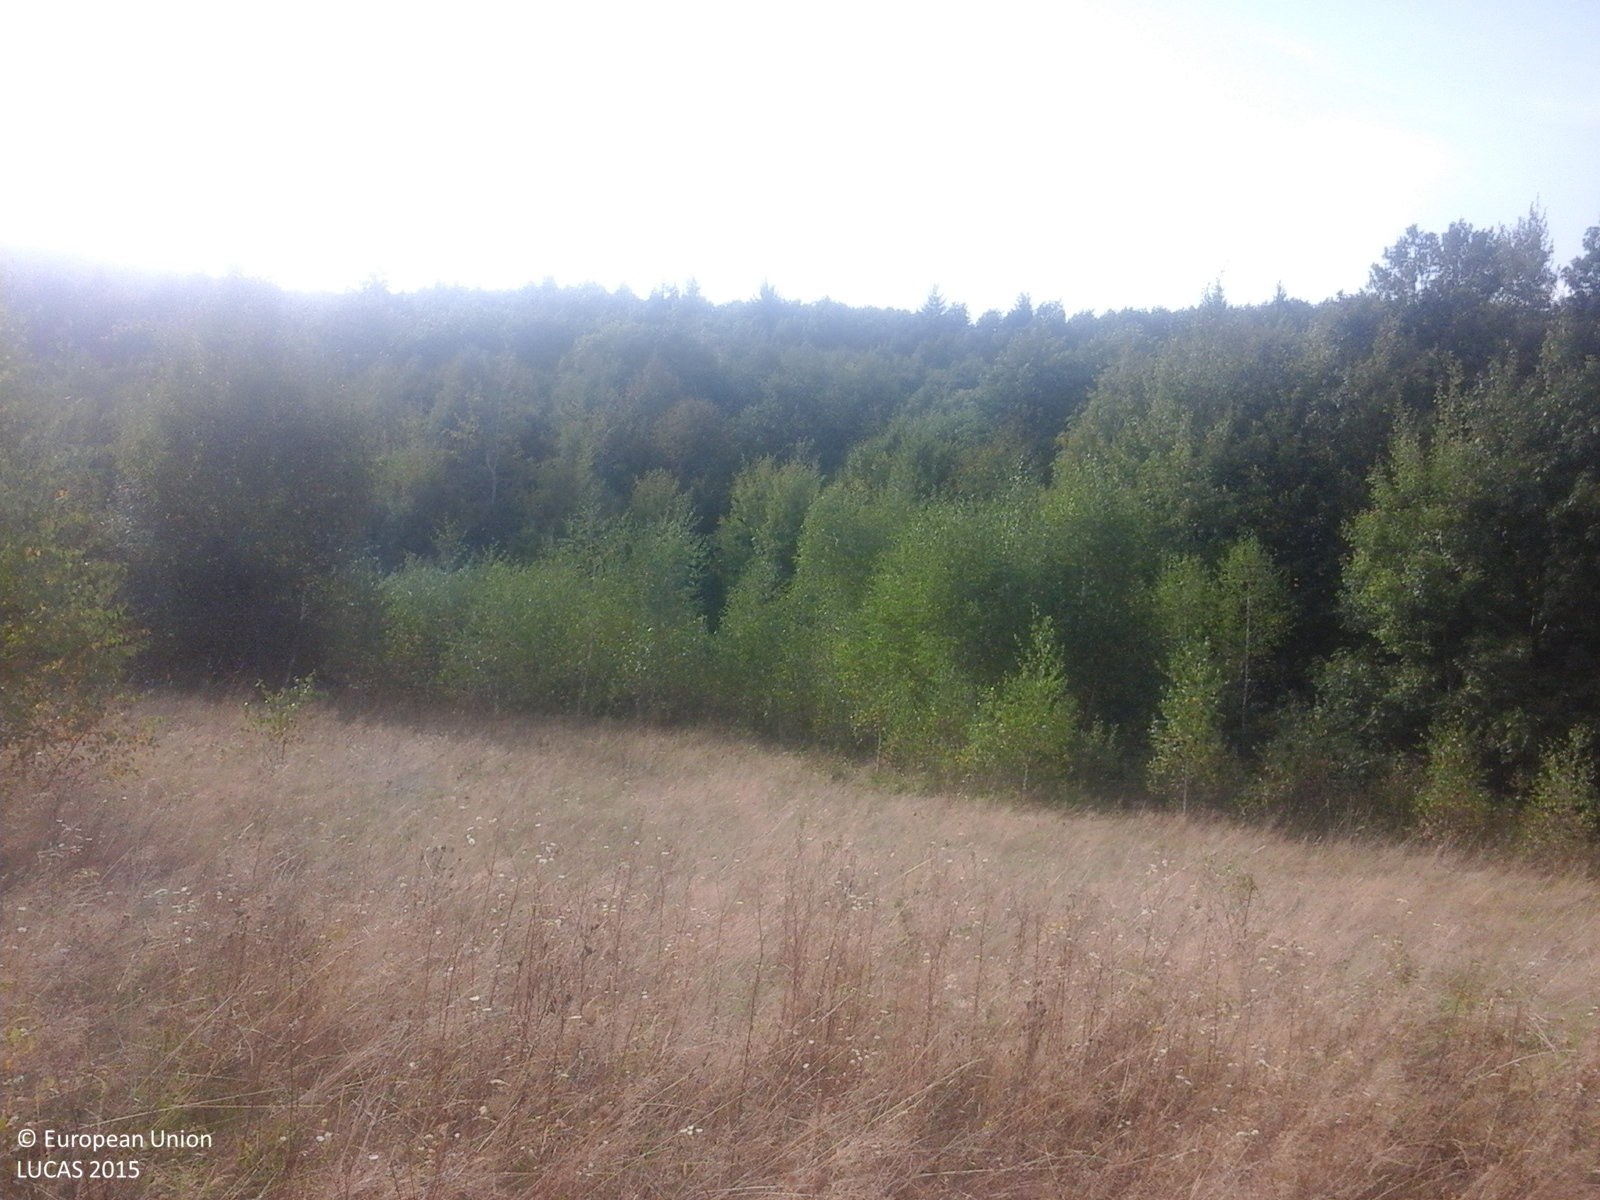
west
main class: Grassland
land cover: Grassland without tree/shrub cover
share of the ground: > 75 %
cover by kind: herbaceous plants 100 %
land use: Agriculture (excluding fallow land and kitchen gardens)
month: September
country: RO
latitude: 47.0028
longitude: 22.7764
